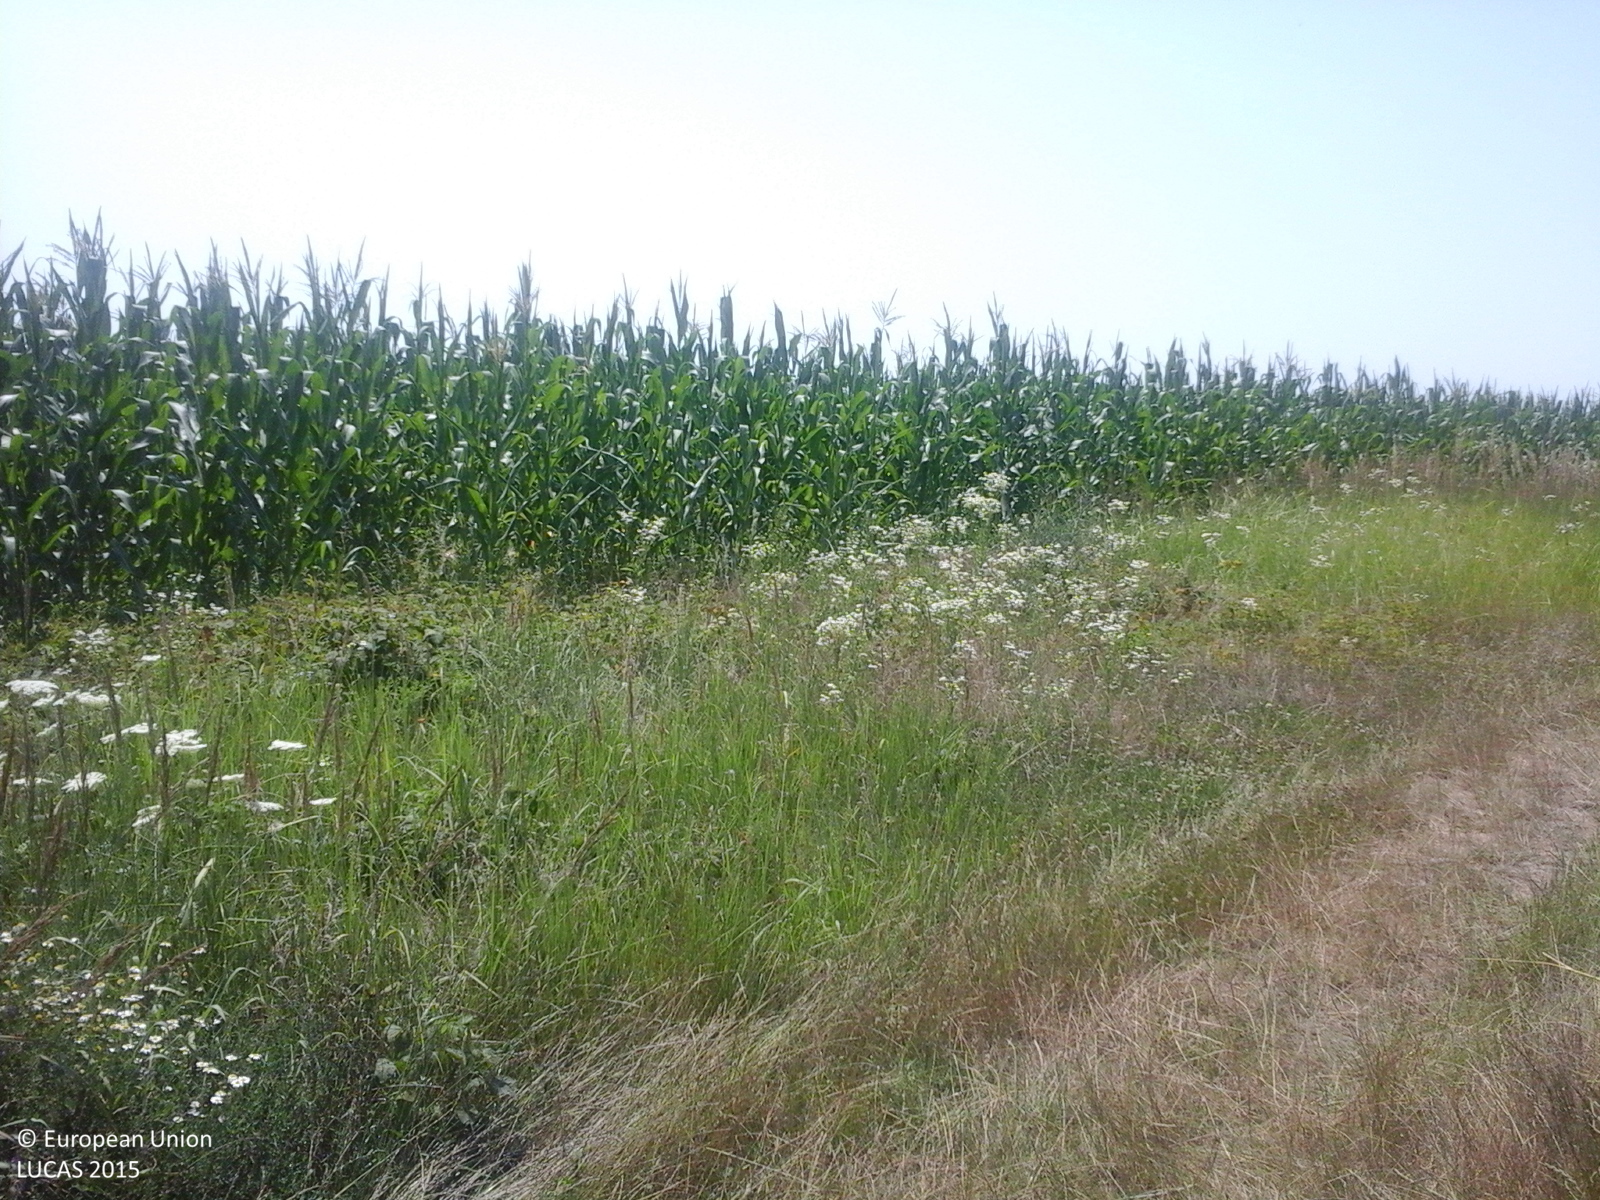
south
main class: Cropland
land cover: Maize
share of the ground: > 75 %
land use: Agriculture (excluding fallow land and kitchen gardens)
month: July
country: RO
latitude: 44.6777
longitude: 25.5226
